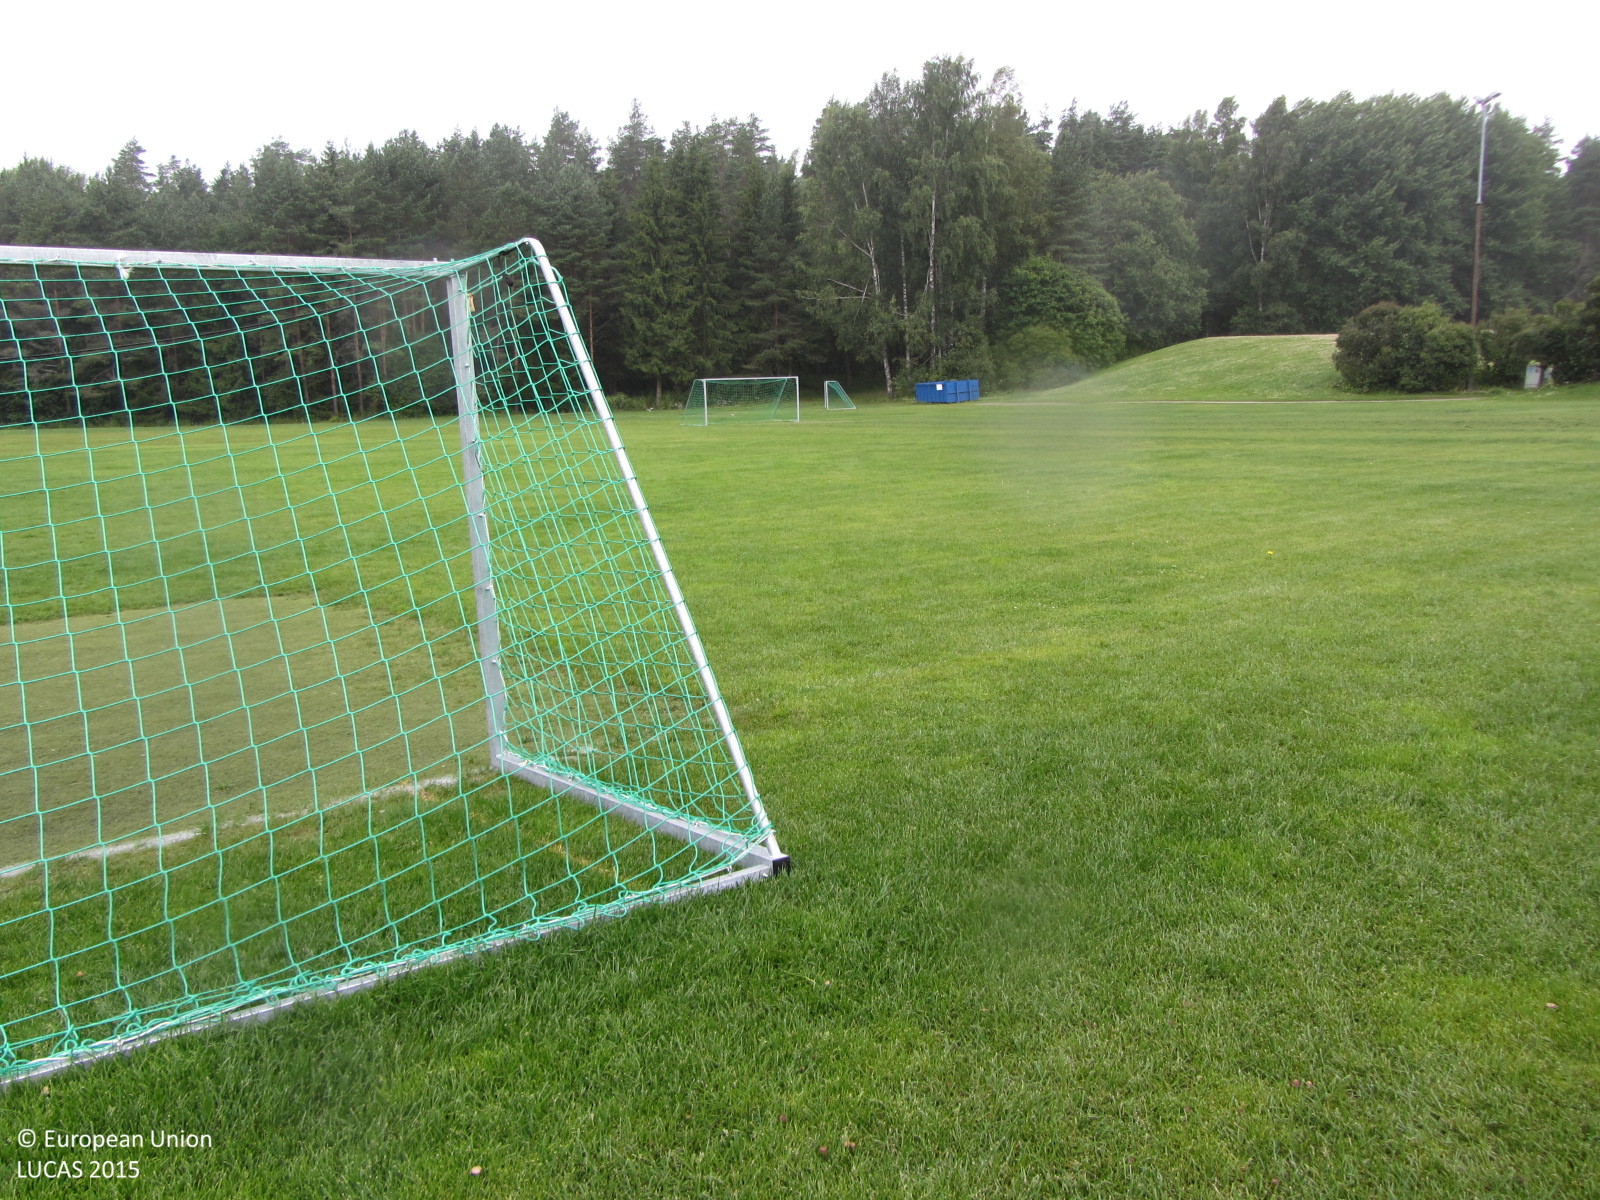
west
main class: Grassland
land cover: Grassland without tree/shrub cover
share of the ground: > 75 %
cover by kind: herbaceous plants 100 %
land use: Sport
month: July
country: FI
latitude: 60.6395
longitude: 24.8312
